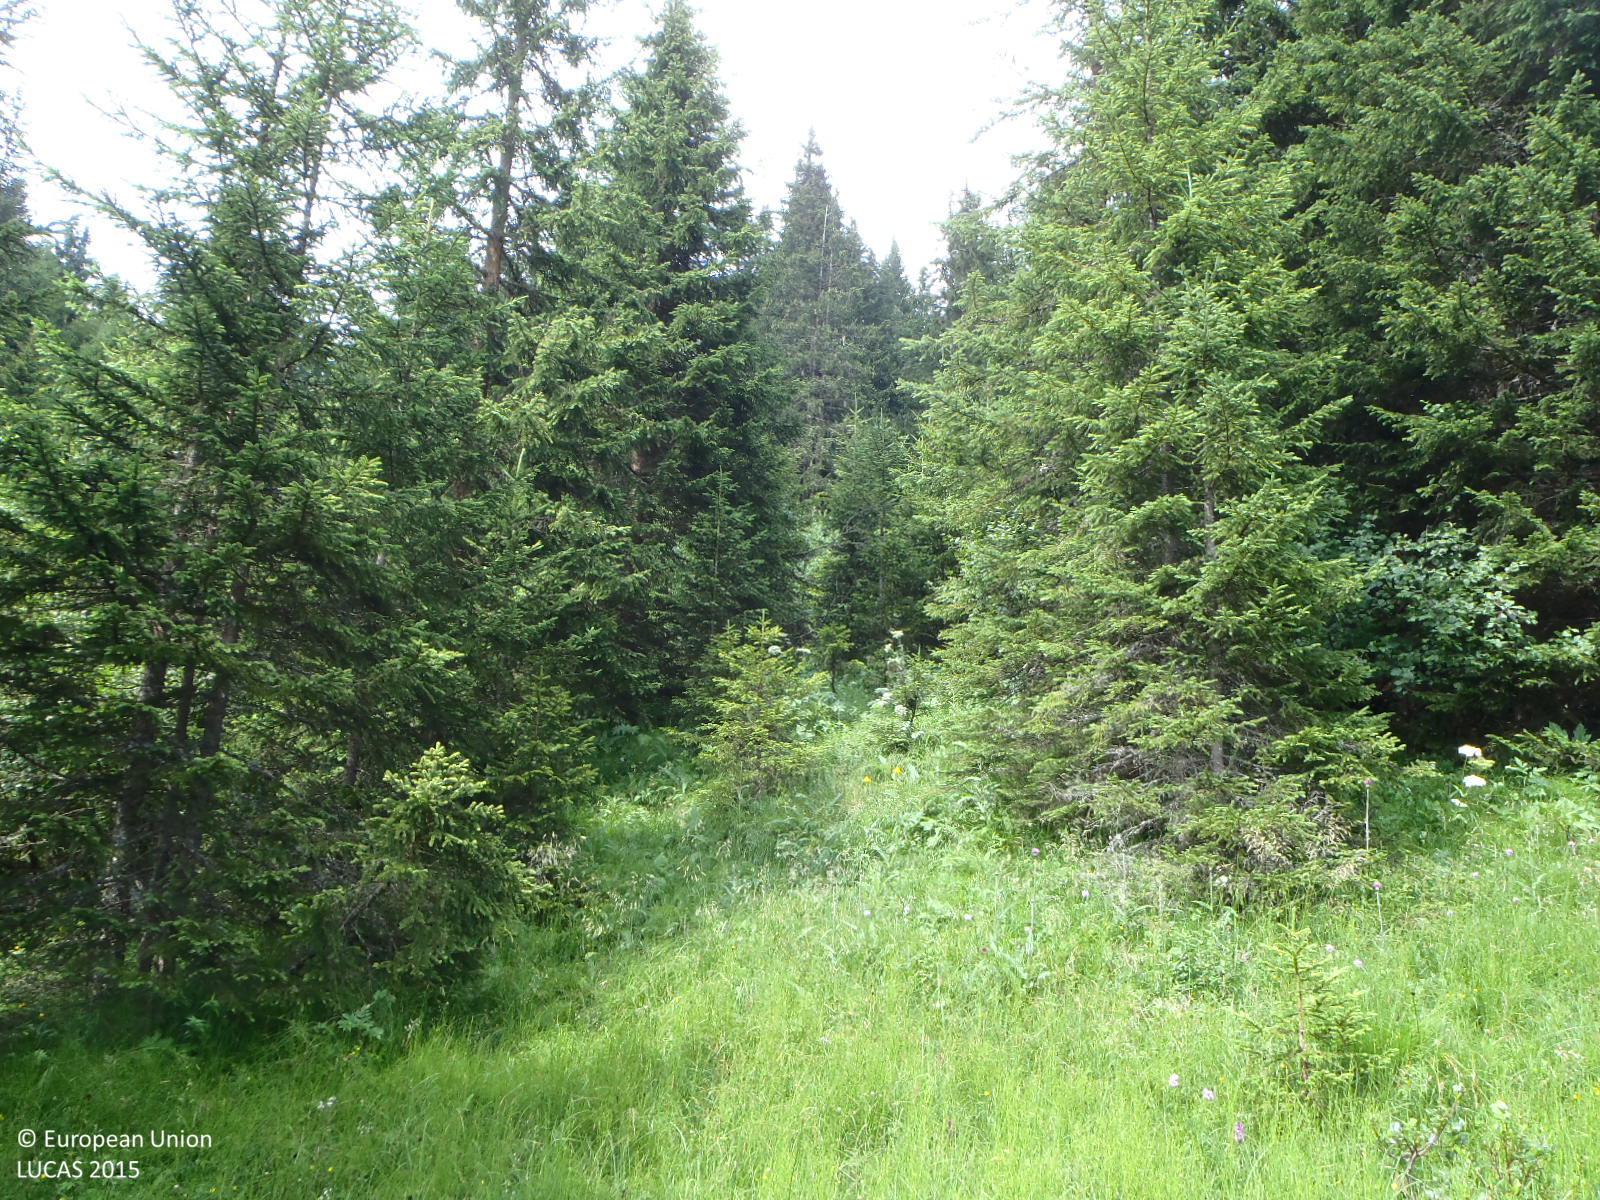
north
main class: Grassland
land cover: Grassland without tree/shrub cover
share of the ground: > 75 %
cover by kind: herbaceous plants 100 %
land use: Agriculture (excluding fallow land and kitchen gardens)
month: July
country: AT
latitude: 47.1838
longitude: 11.7272
